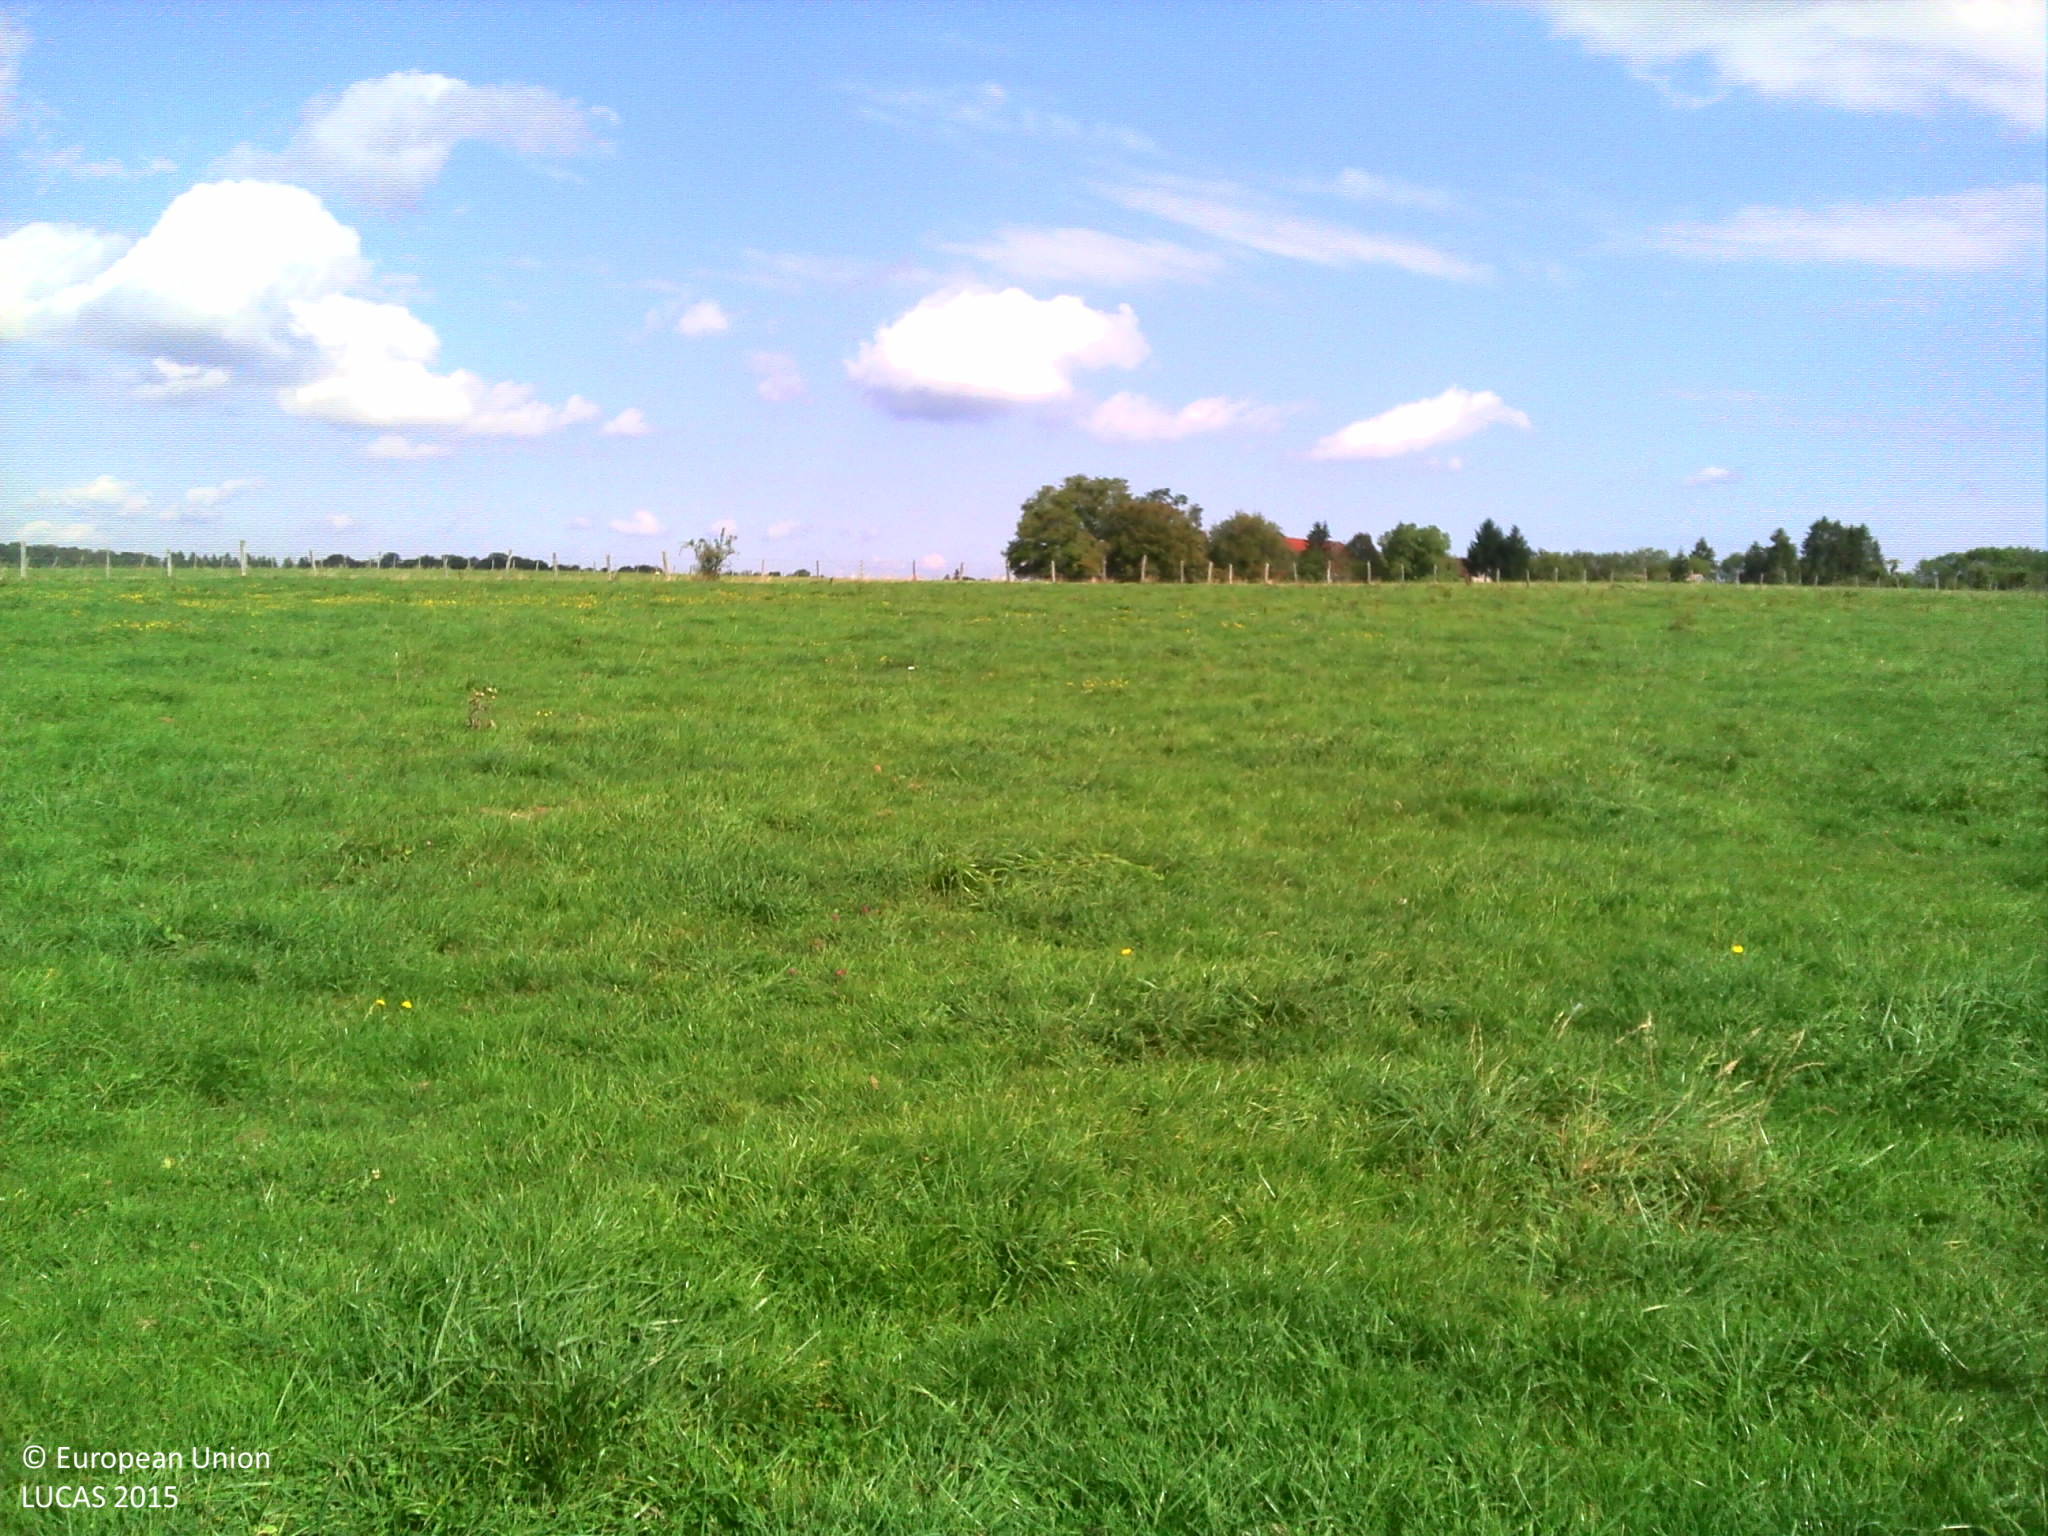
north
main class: Grassland
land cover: Grassland without tree/shrub cover
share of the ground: > 75 %
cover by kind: herbaceous plants 100 %
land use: Agriculture (excluding fallow land and kitchen gardens)
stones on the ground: < 10 %
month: September
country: FR
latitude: 47.1730
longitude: 6.3737
